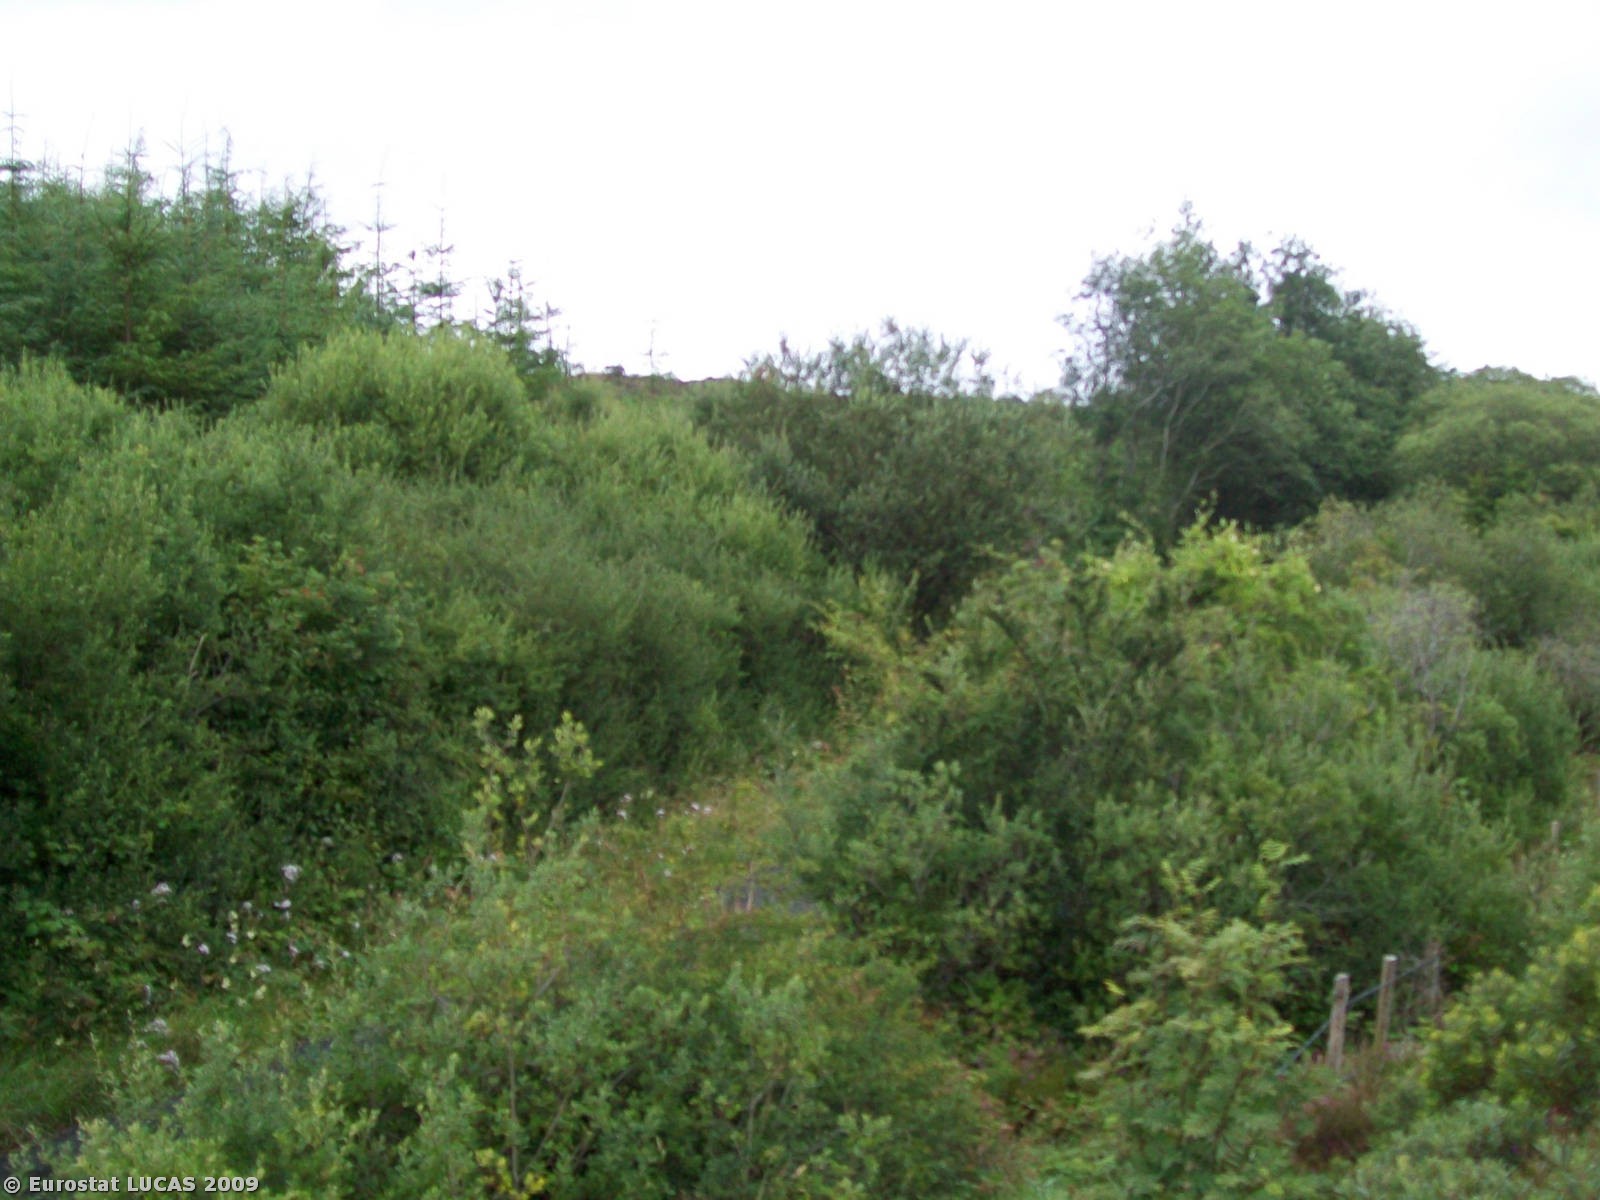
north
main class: Woodland
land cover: Coniferous woodland
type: plantations and self-sown exotic forest
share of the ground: > 75 %
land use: Forestry
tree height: > 5 m
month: July
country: IE
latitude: 53.9580
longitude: -9.0665
